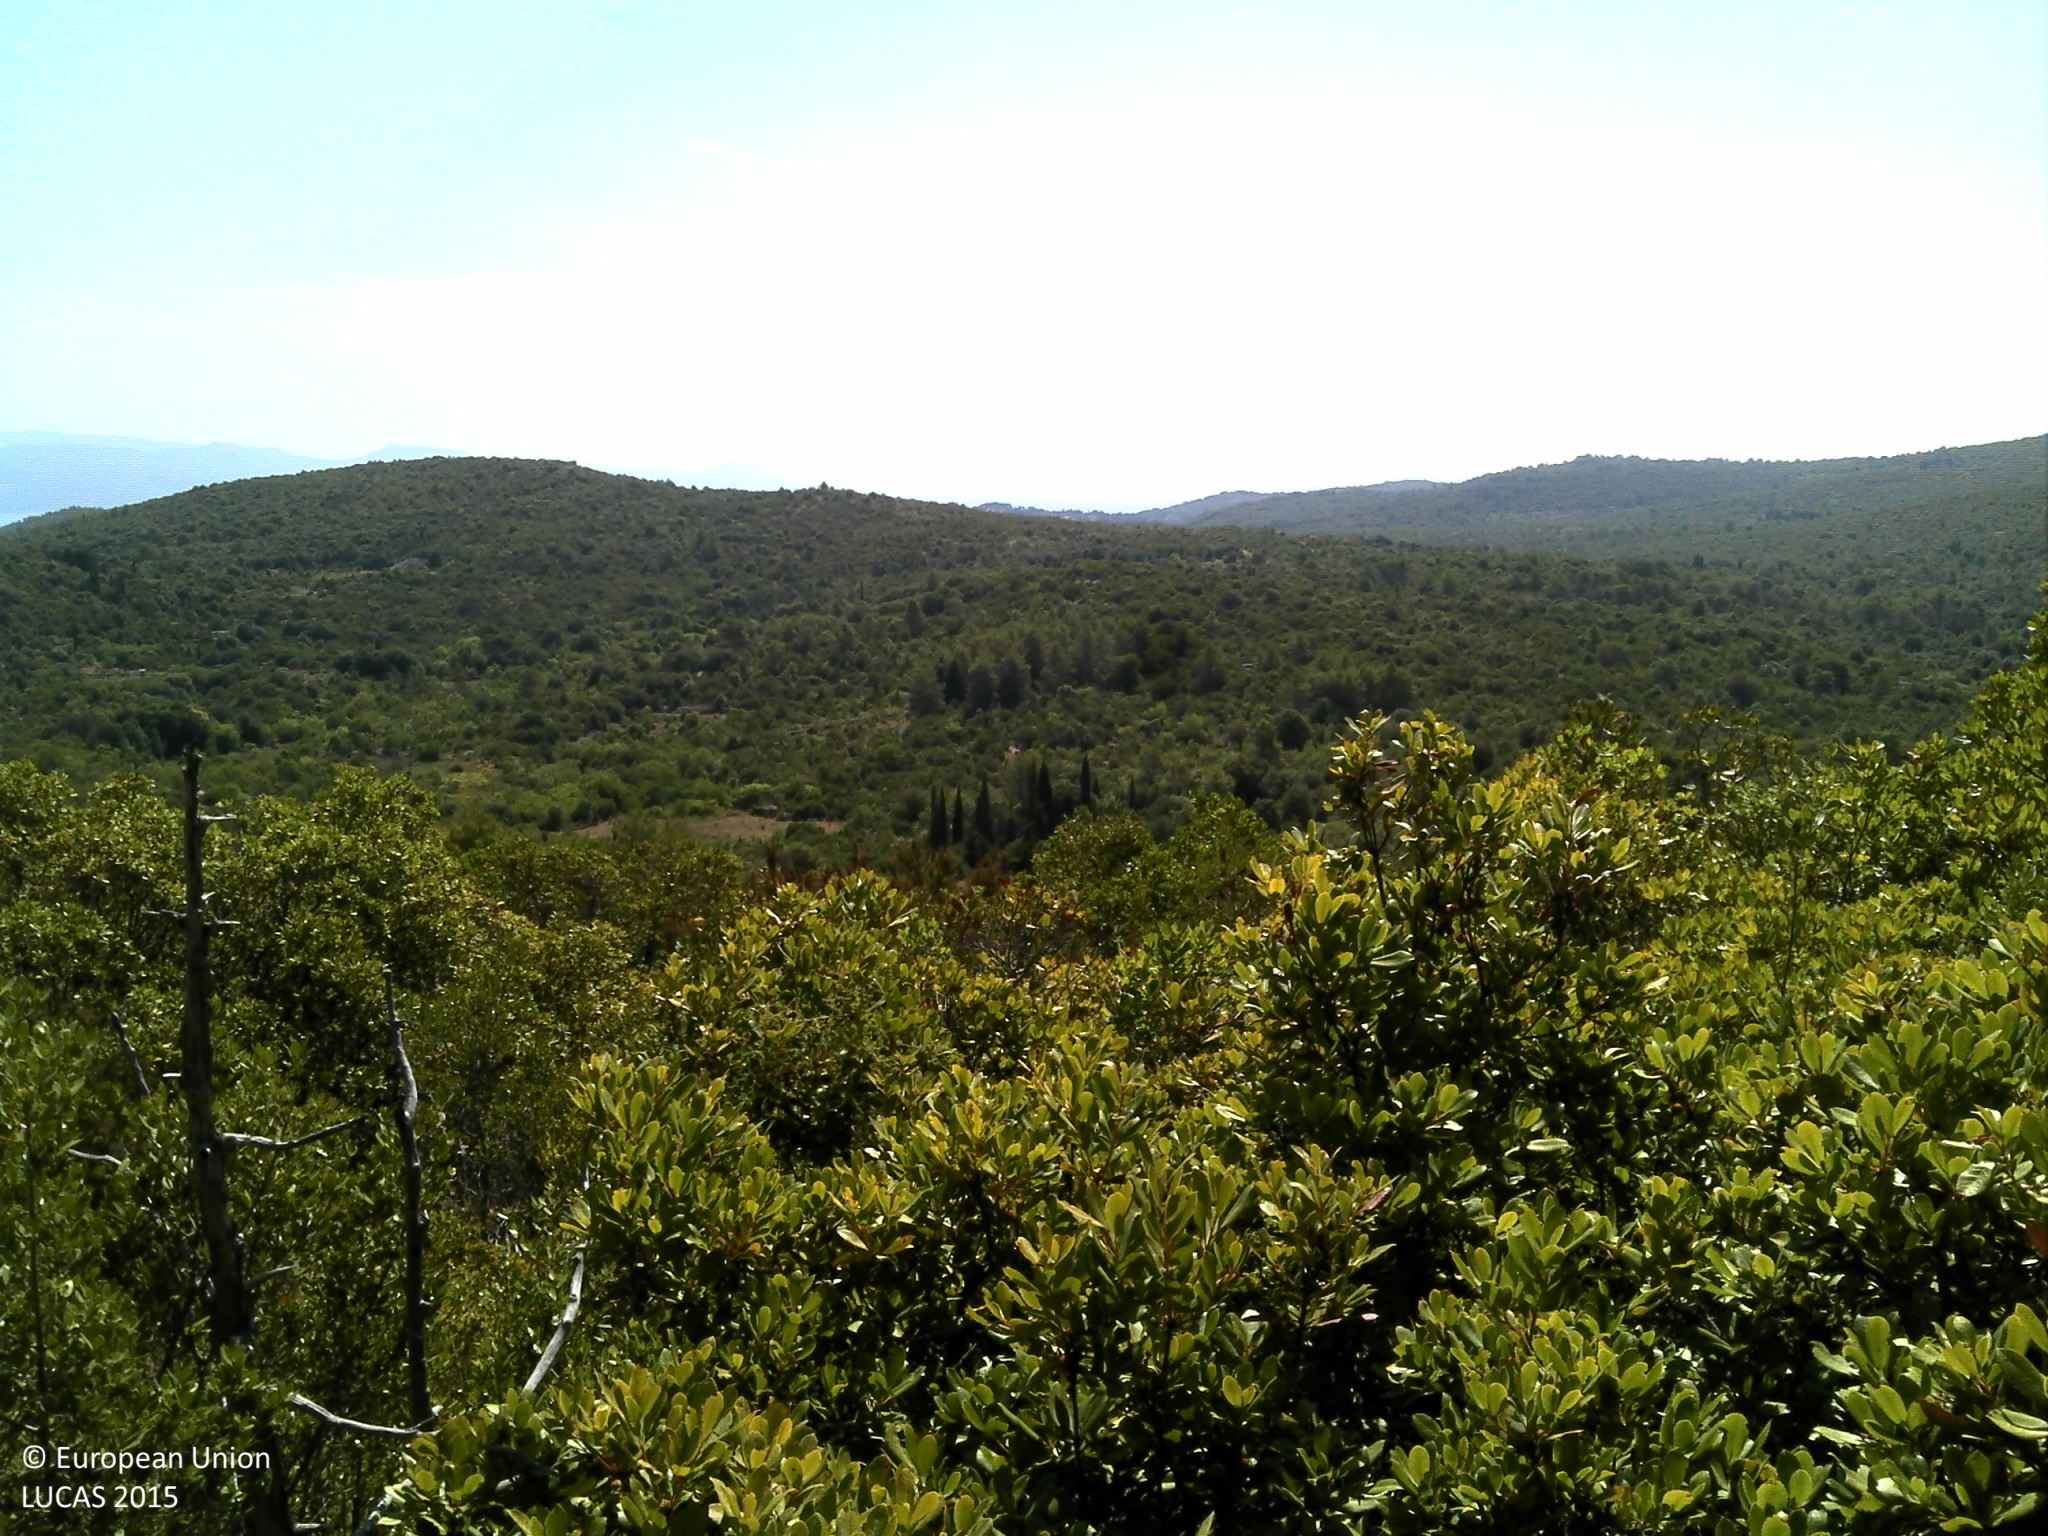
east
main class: Shrubland
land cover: Shrubland without tree cover
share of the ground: 50 - 75 %
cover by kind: shrubs 60 %, consolidated bare surface 15 %, unconsolidated bare surface 15 %, herbaceous plants 10 %
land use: Semi-natural and natural areas not in use
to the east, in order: Shrubland without tree cover; Shrubland with sparse tree cover
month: August
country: HR
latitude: 42.9510
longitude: 17.0615
